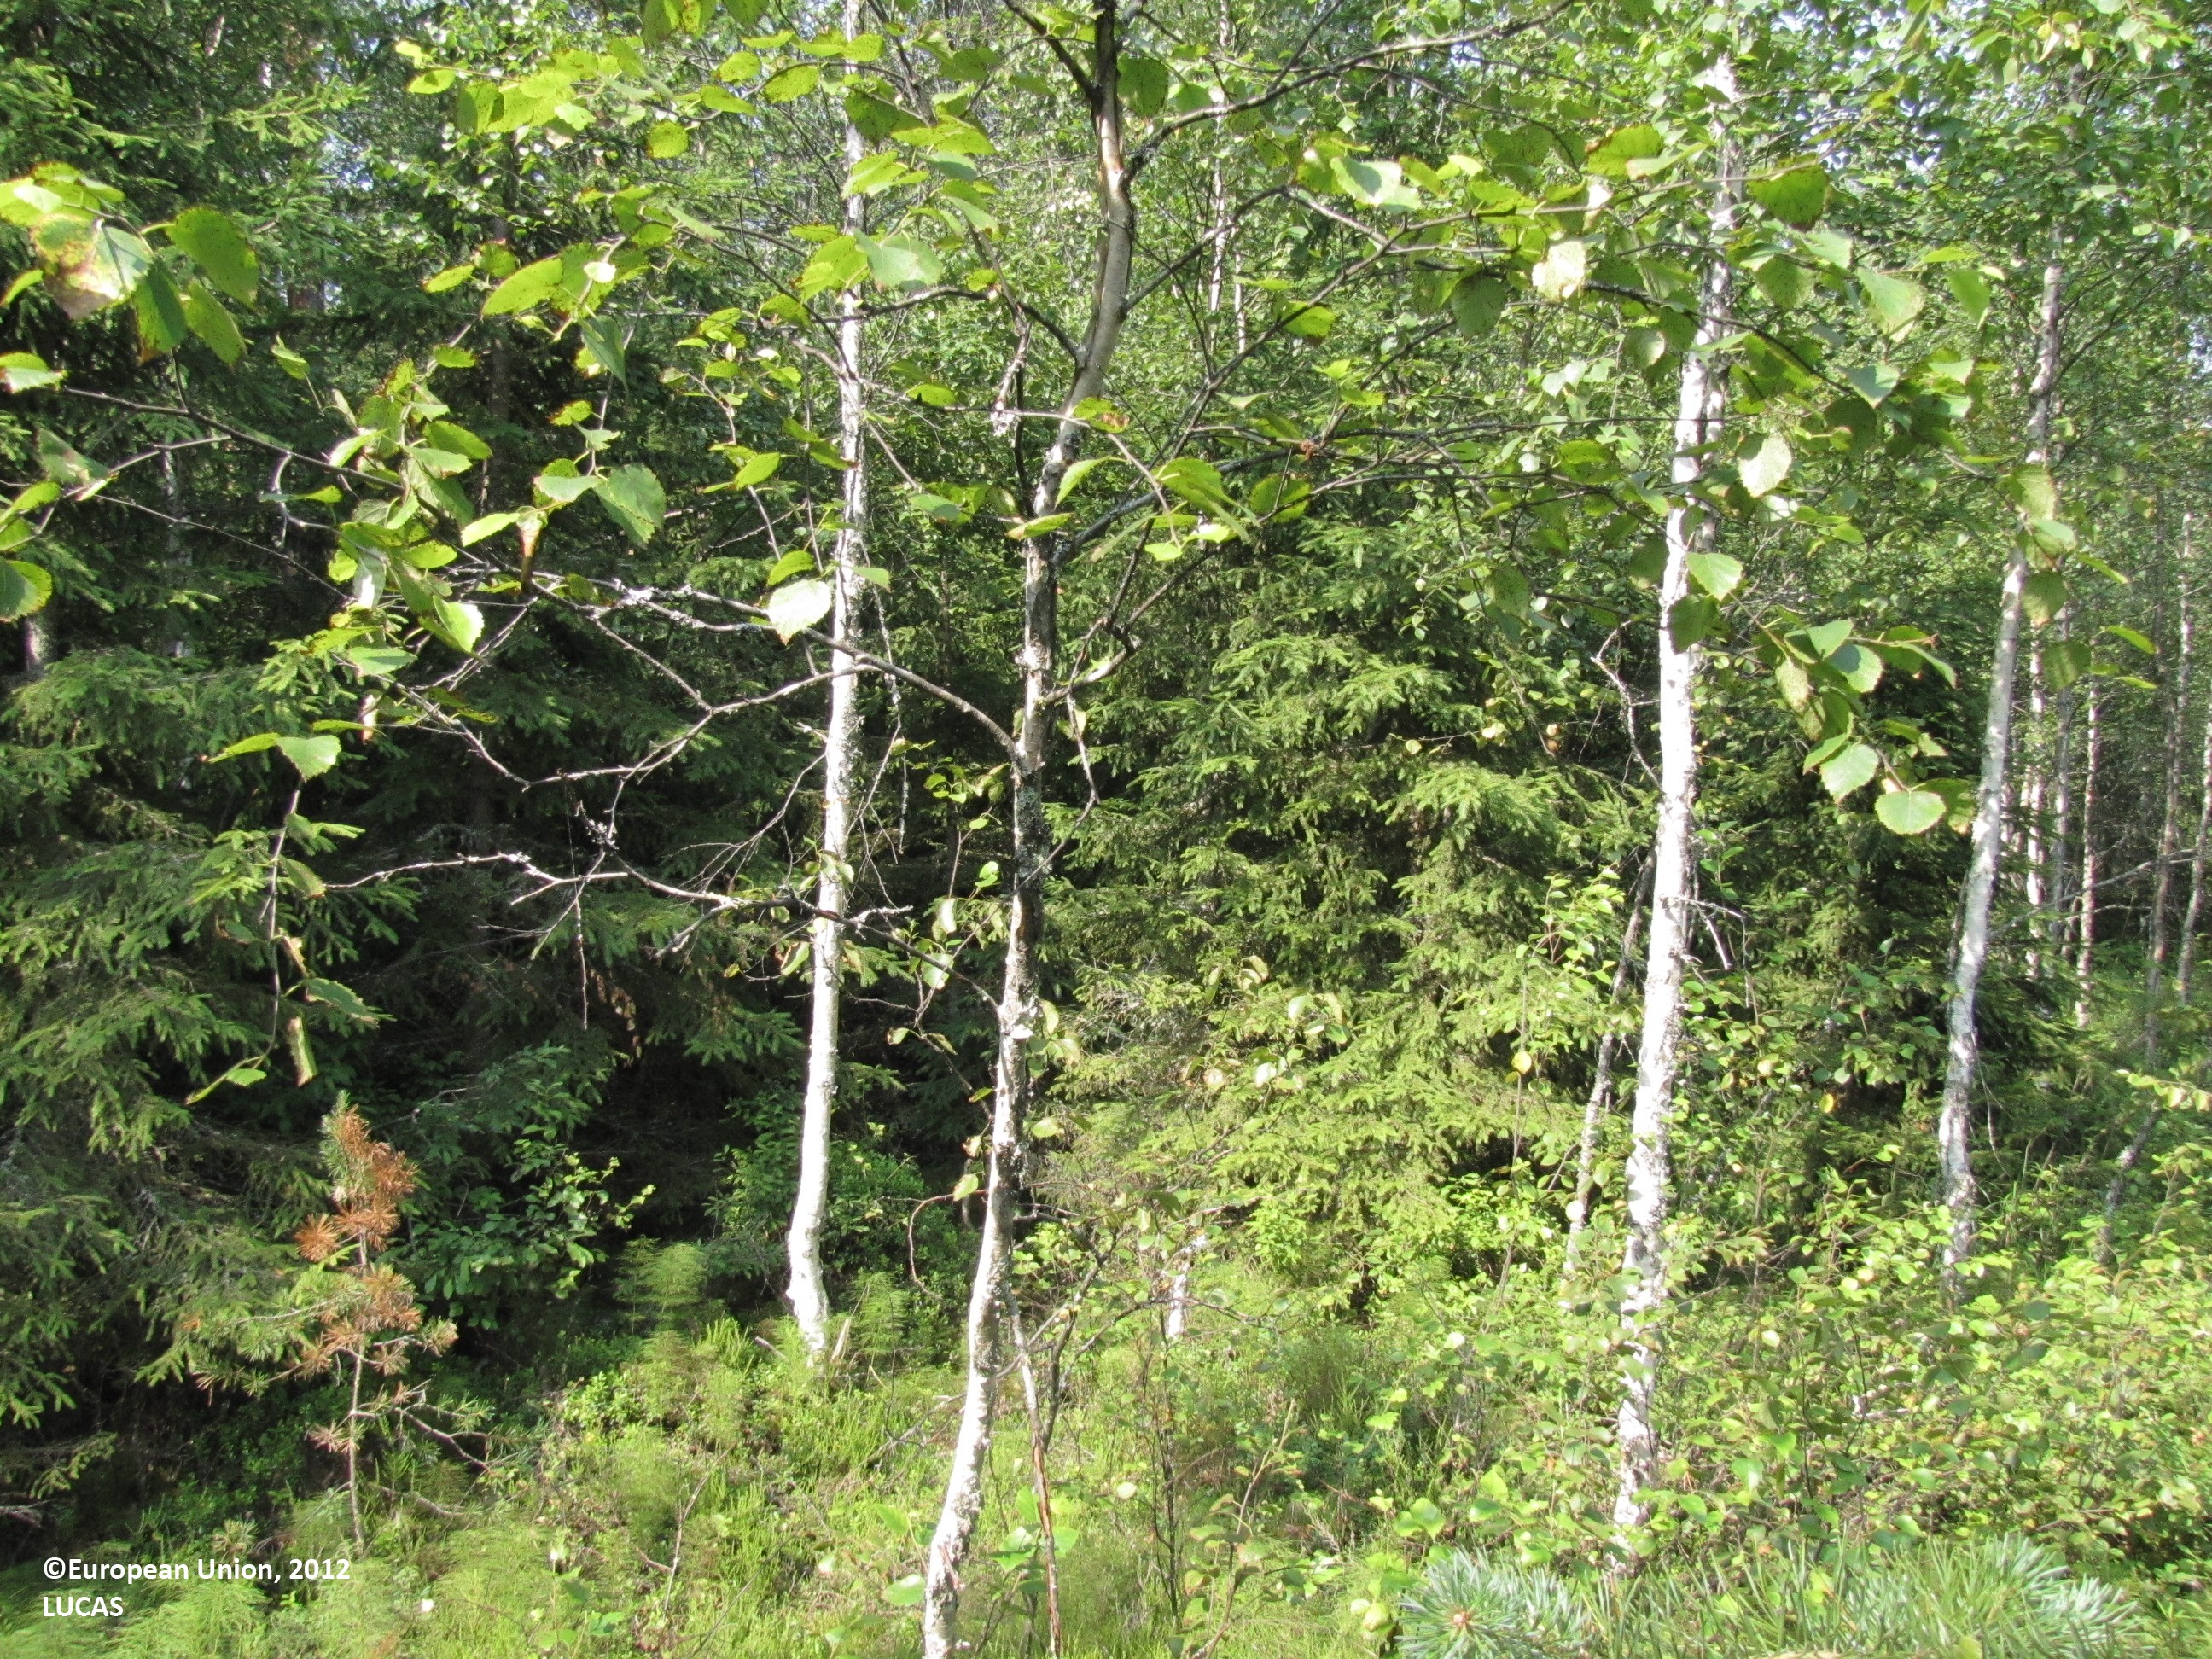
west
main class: Woodland
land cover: Other mixed woodland
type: boreal forest
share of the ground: 50 - 75 %
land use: Forestry
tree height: > 5 m
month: July
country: FI
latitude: 62.0280
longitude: 23.1996
